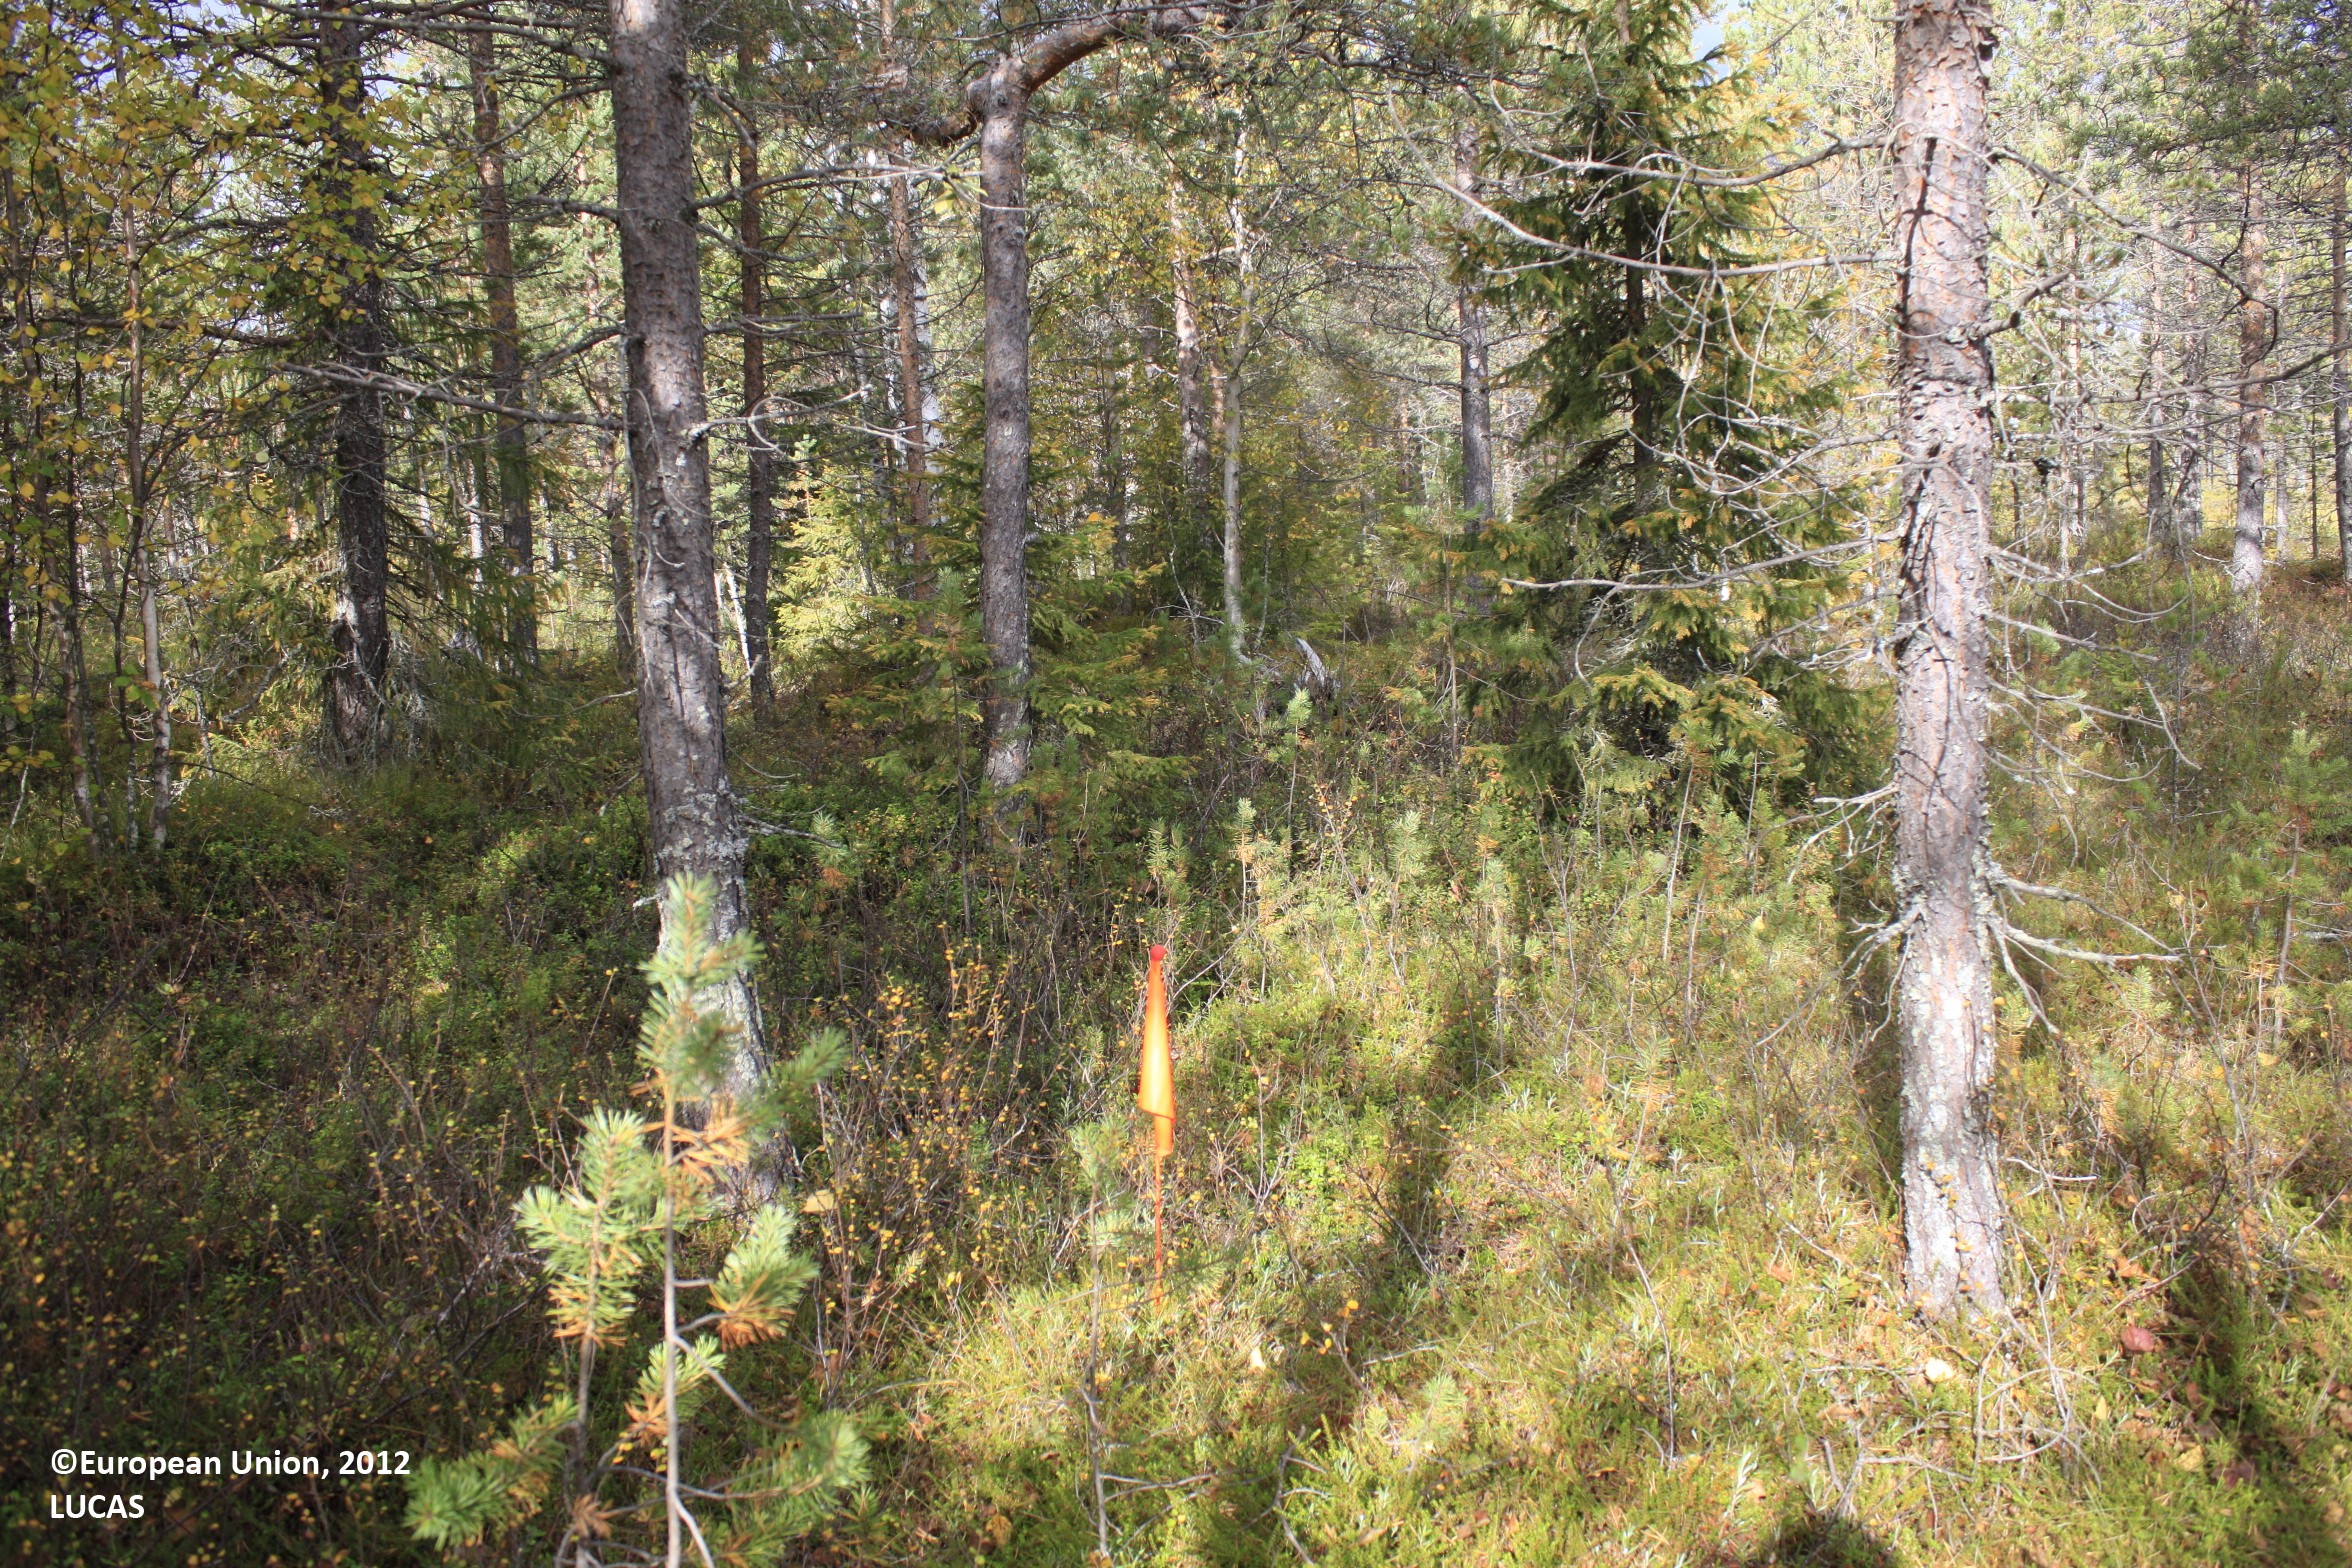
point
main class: Woodland
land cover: Pine dominated mixed woodland
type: mire and swamp forests
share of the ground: 25 - 50 %
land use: Forestry
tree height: > 5 m
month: September
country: FI
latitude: 65.6713
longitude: 26.5684
